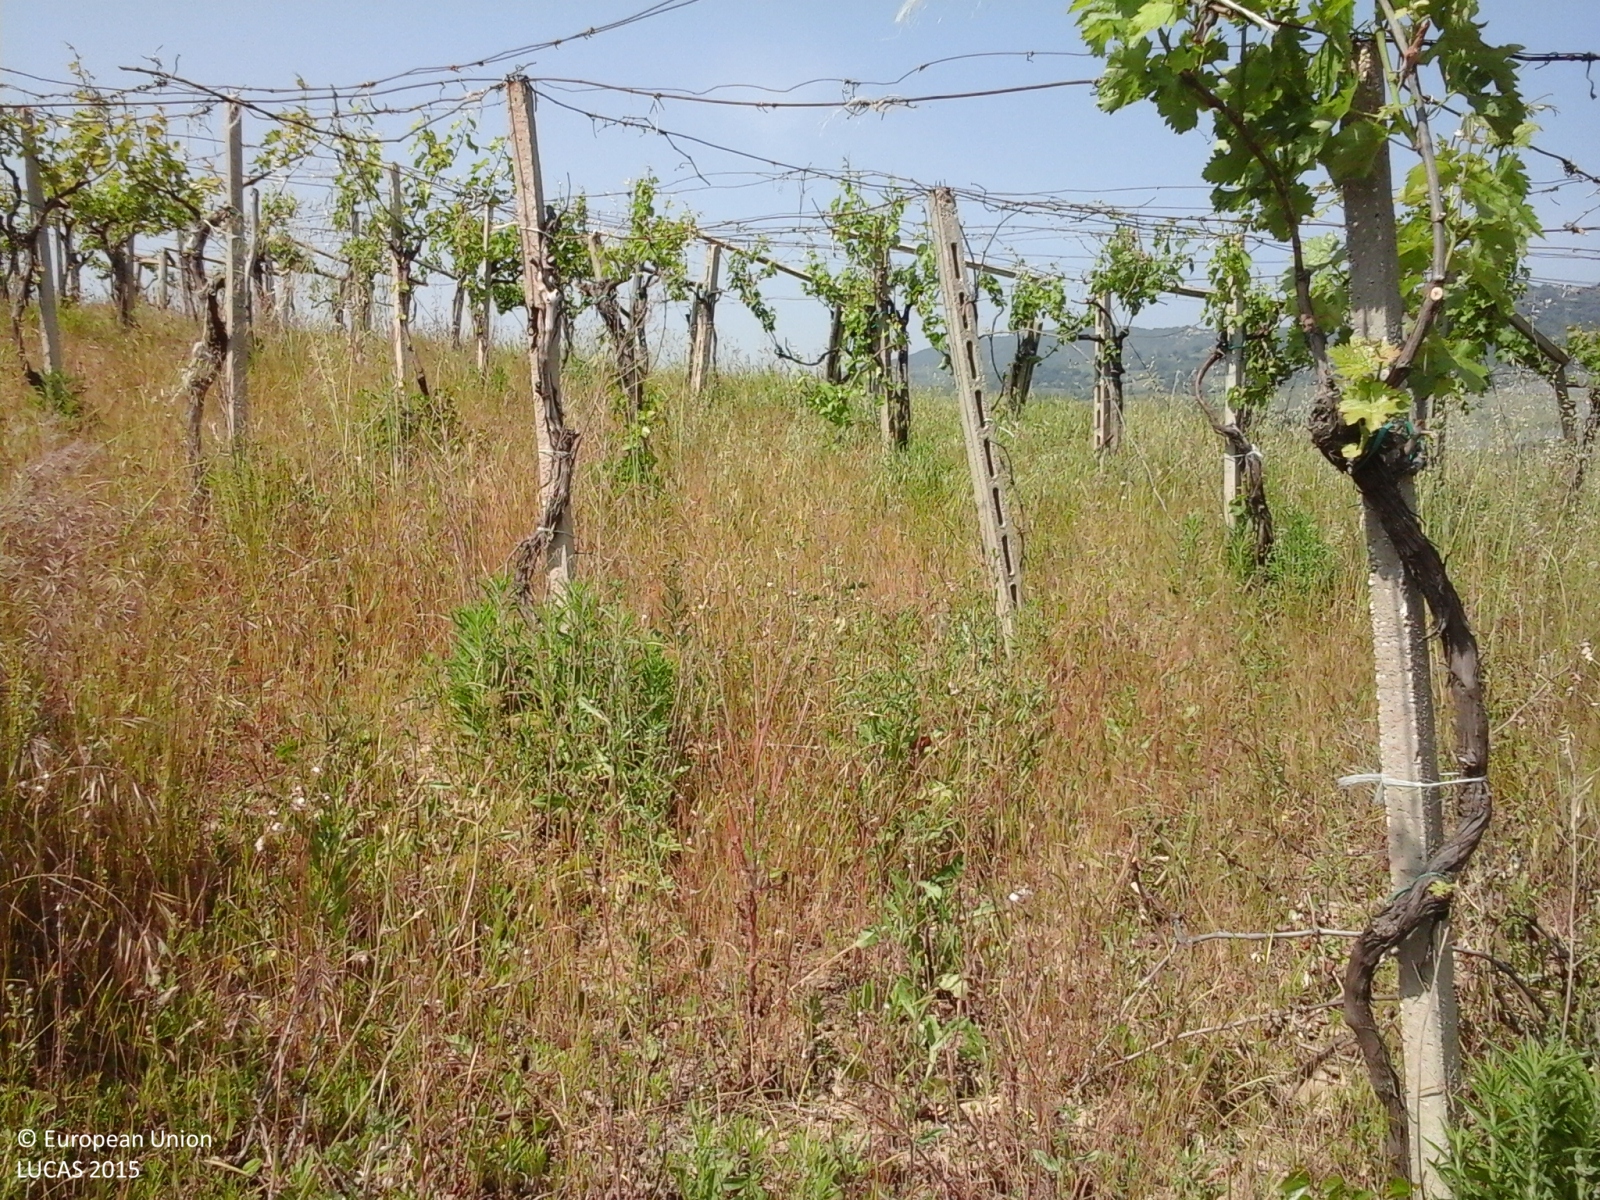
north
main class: Cropland
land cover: Vineyards
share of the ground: 25 - 50 %
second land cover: Spontaneously vegetated surfaces
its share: 25 - 50 %
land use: Agriculture (excluding fallow land and kitchen gardens)
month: May
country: IT
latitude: 41.8981
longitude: 14.6016
